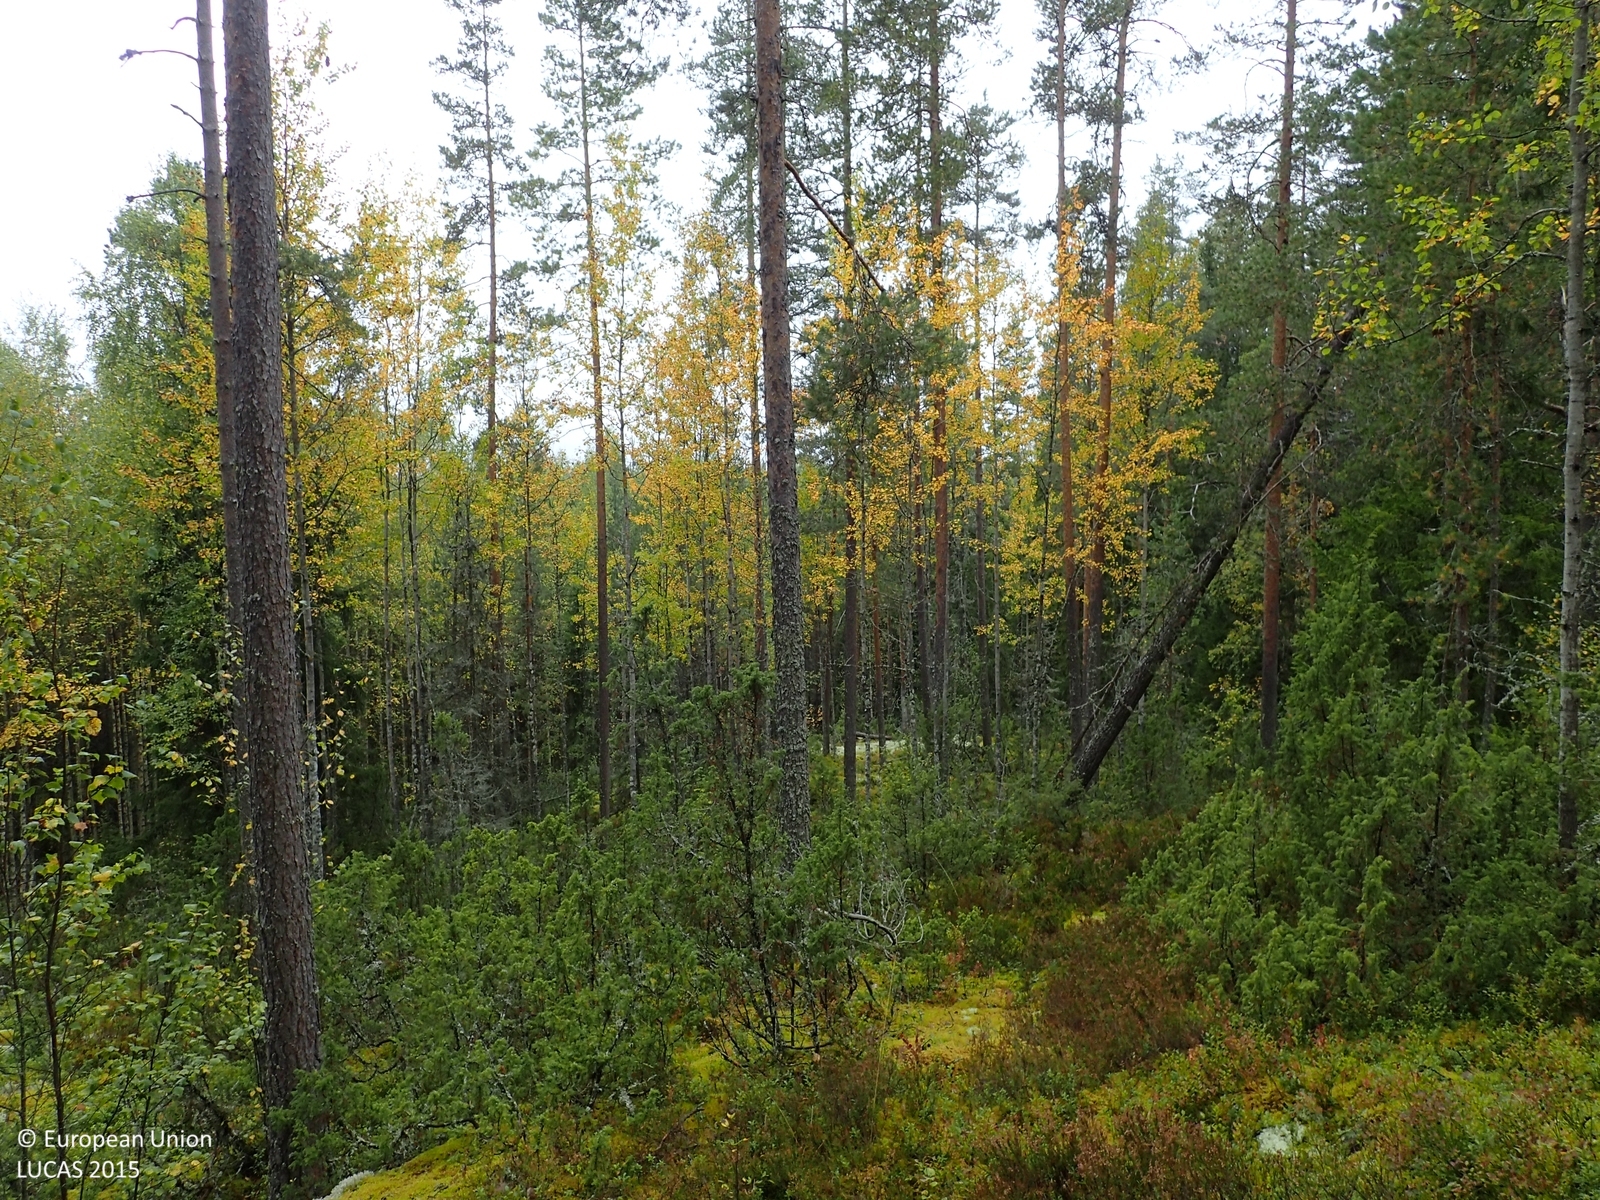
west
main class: Woodland
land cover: Pine dominated mixed woodland
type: boreal forest
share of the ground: > 75 %
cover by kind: coniferous forest trees 55 %, broadleaved forest trees 20 %, lichens and mosses 15 %, shrubs 10 %
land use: Forestry
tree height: > 5 m
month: September
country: FI
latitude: 63.0650
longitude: 25.6022
